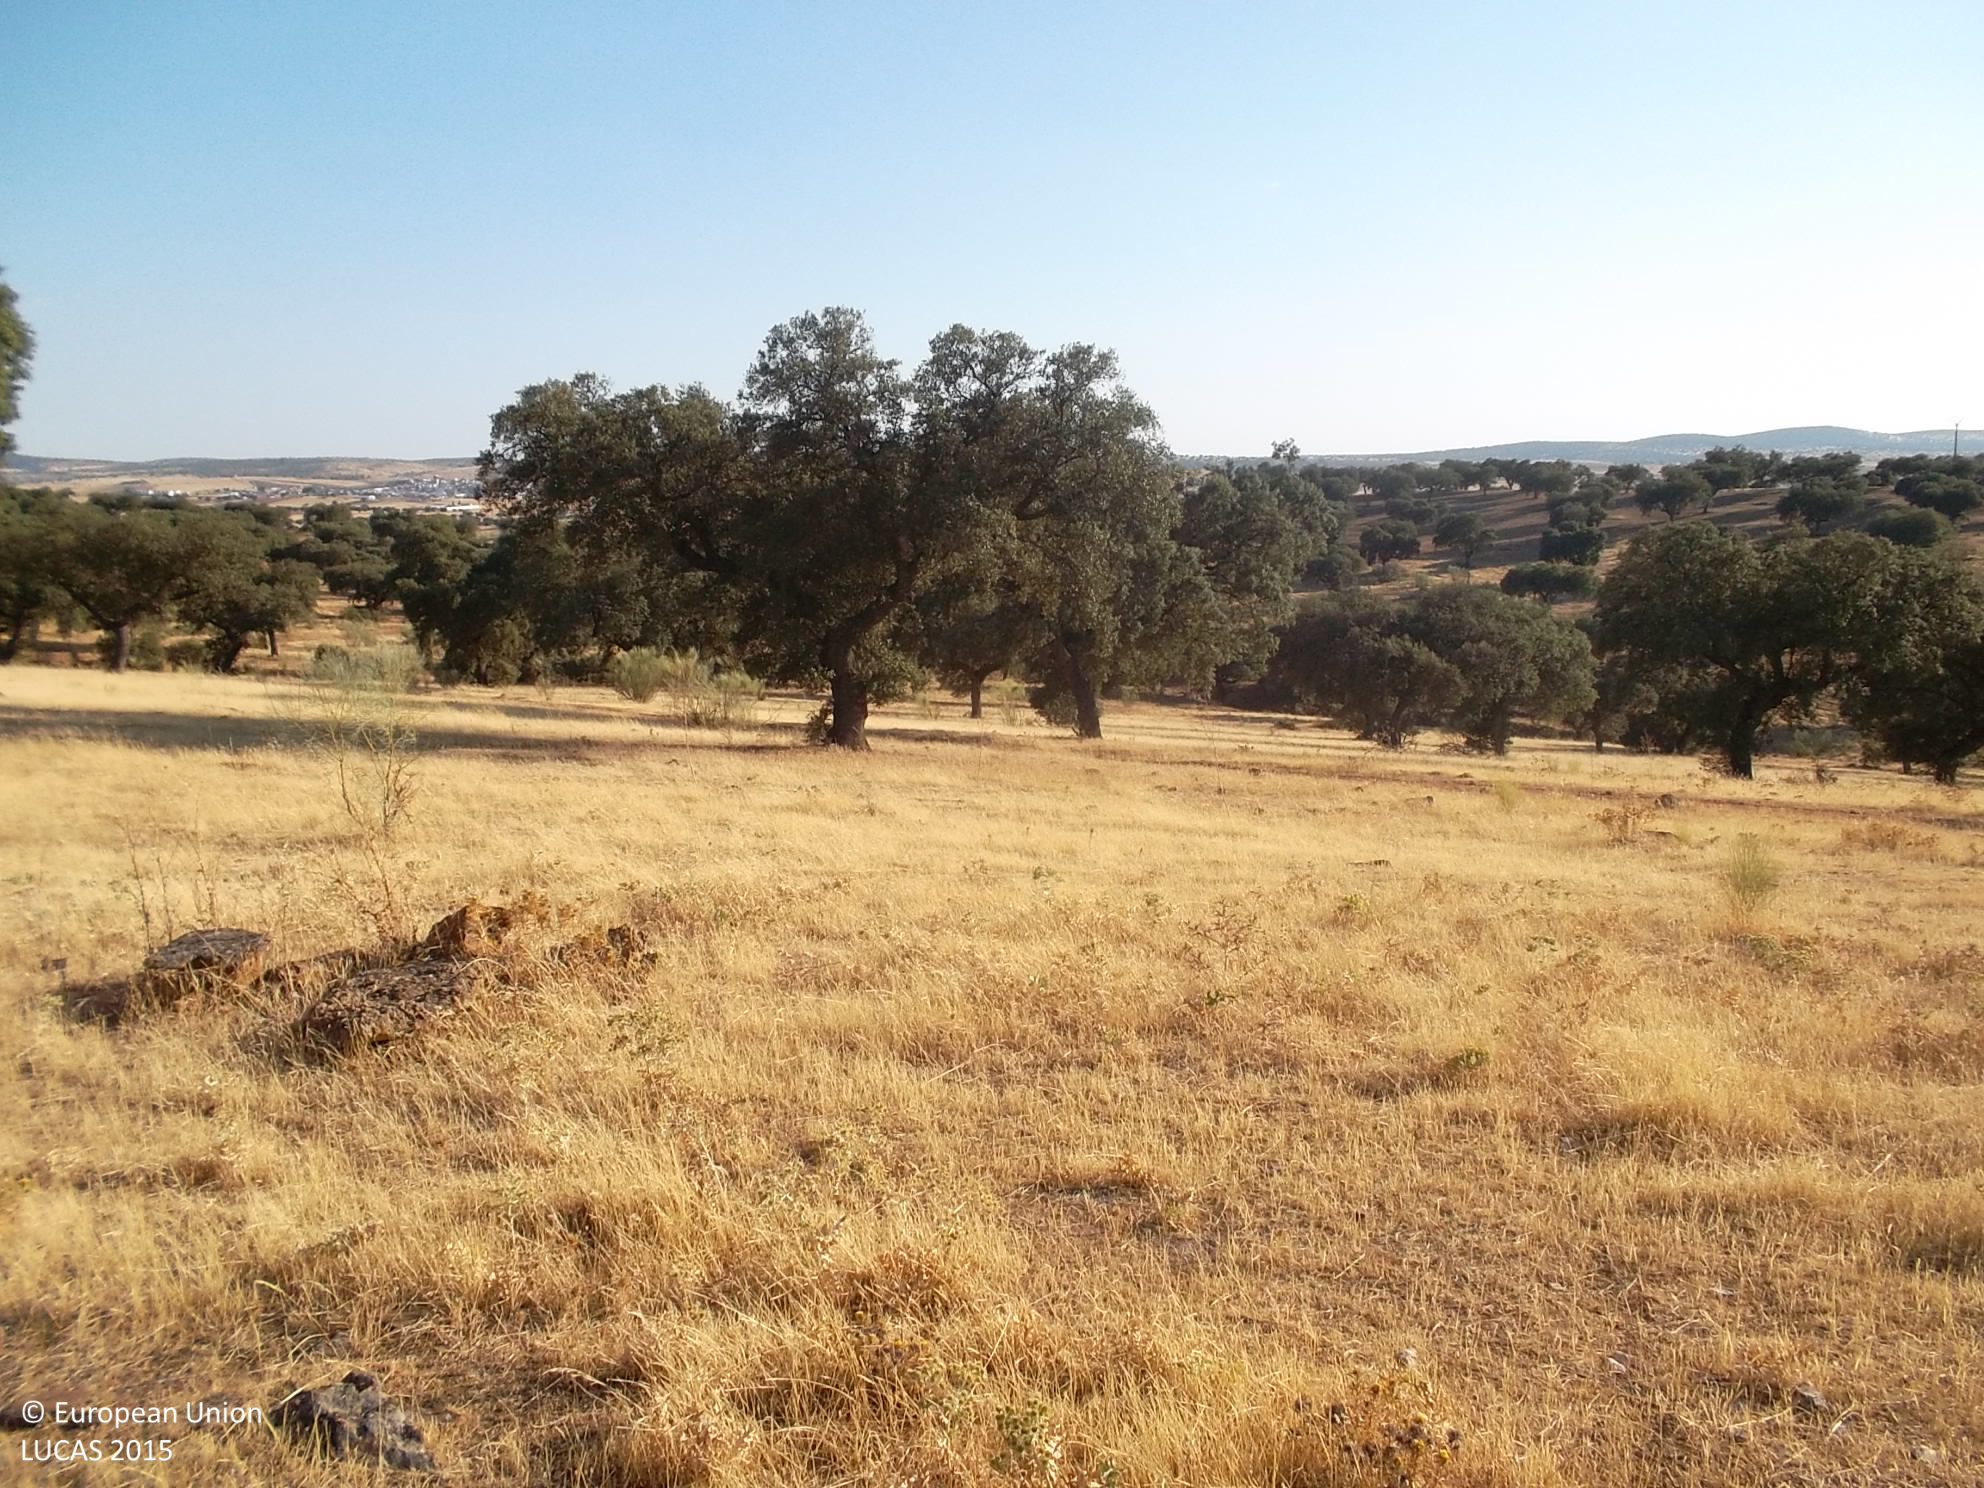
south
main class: Grassland
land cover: Grassland with sparse tree/shrub cover
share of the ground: > 75 %
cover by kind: herbaceous plants 90 %, broadleaved forest trees 5 %, shrubs 5 %
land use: Agriculture (excluding fallow land and kitchen gardens)
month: July
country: ES
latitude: 38.5338
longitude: -5.8150
